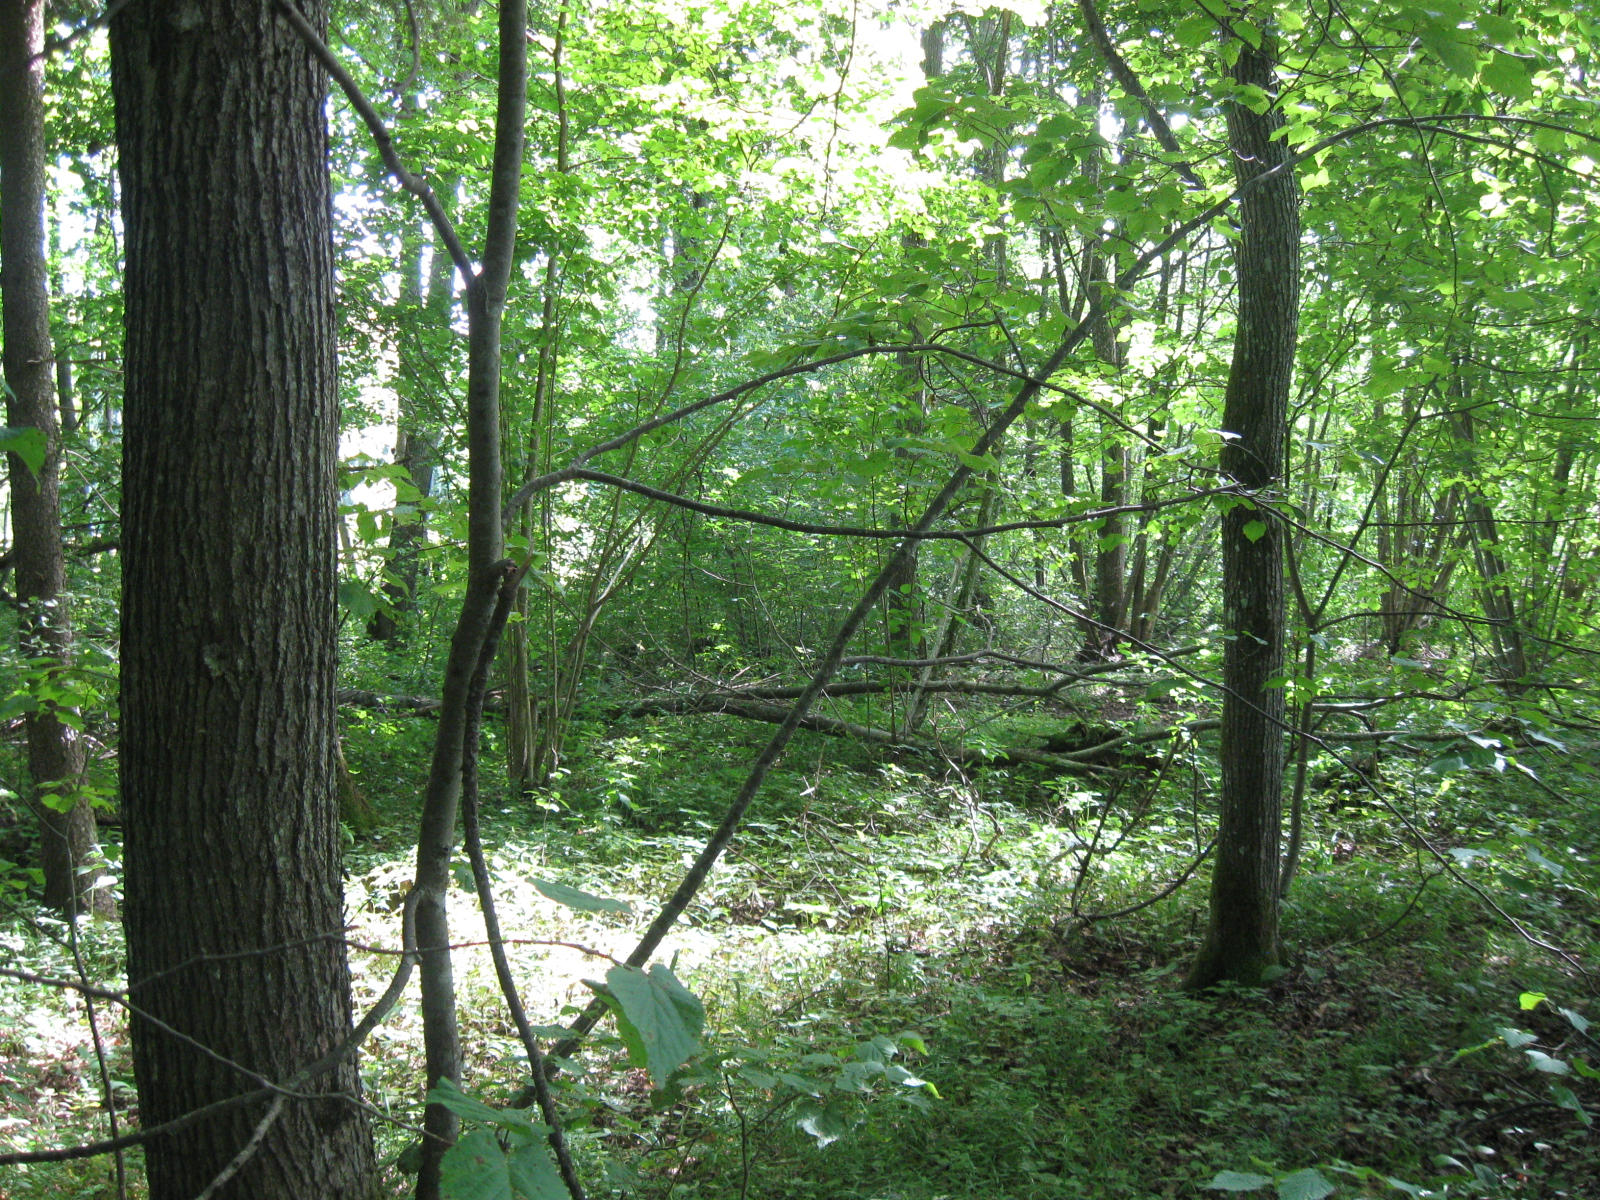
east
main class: Woodland
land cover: Other mixed woodland
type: hemiboreal forest and nemoral coniferous forest and mixed broadleaved-coniferous forest
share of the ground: > 75 %
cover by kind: broadleaved forest trees 65 %, coniferous forest trees 30 %, herbaceous plants 5 %
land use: Forestry
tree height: > 5 m
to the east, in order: Other mixed woodland; Broadleaved woodland; Ditches and canals; Shruby margins; Paved roads, cycling and walking lanes; Spontaneously vegetated surfaces; Ditches and canals; Other mixed woodland
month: July
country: LT
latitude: 54.9742
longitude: 23.6921
